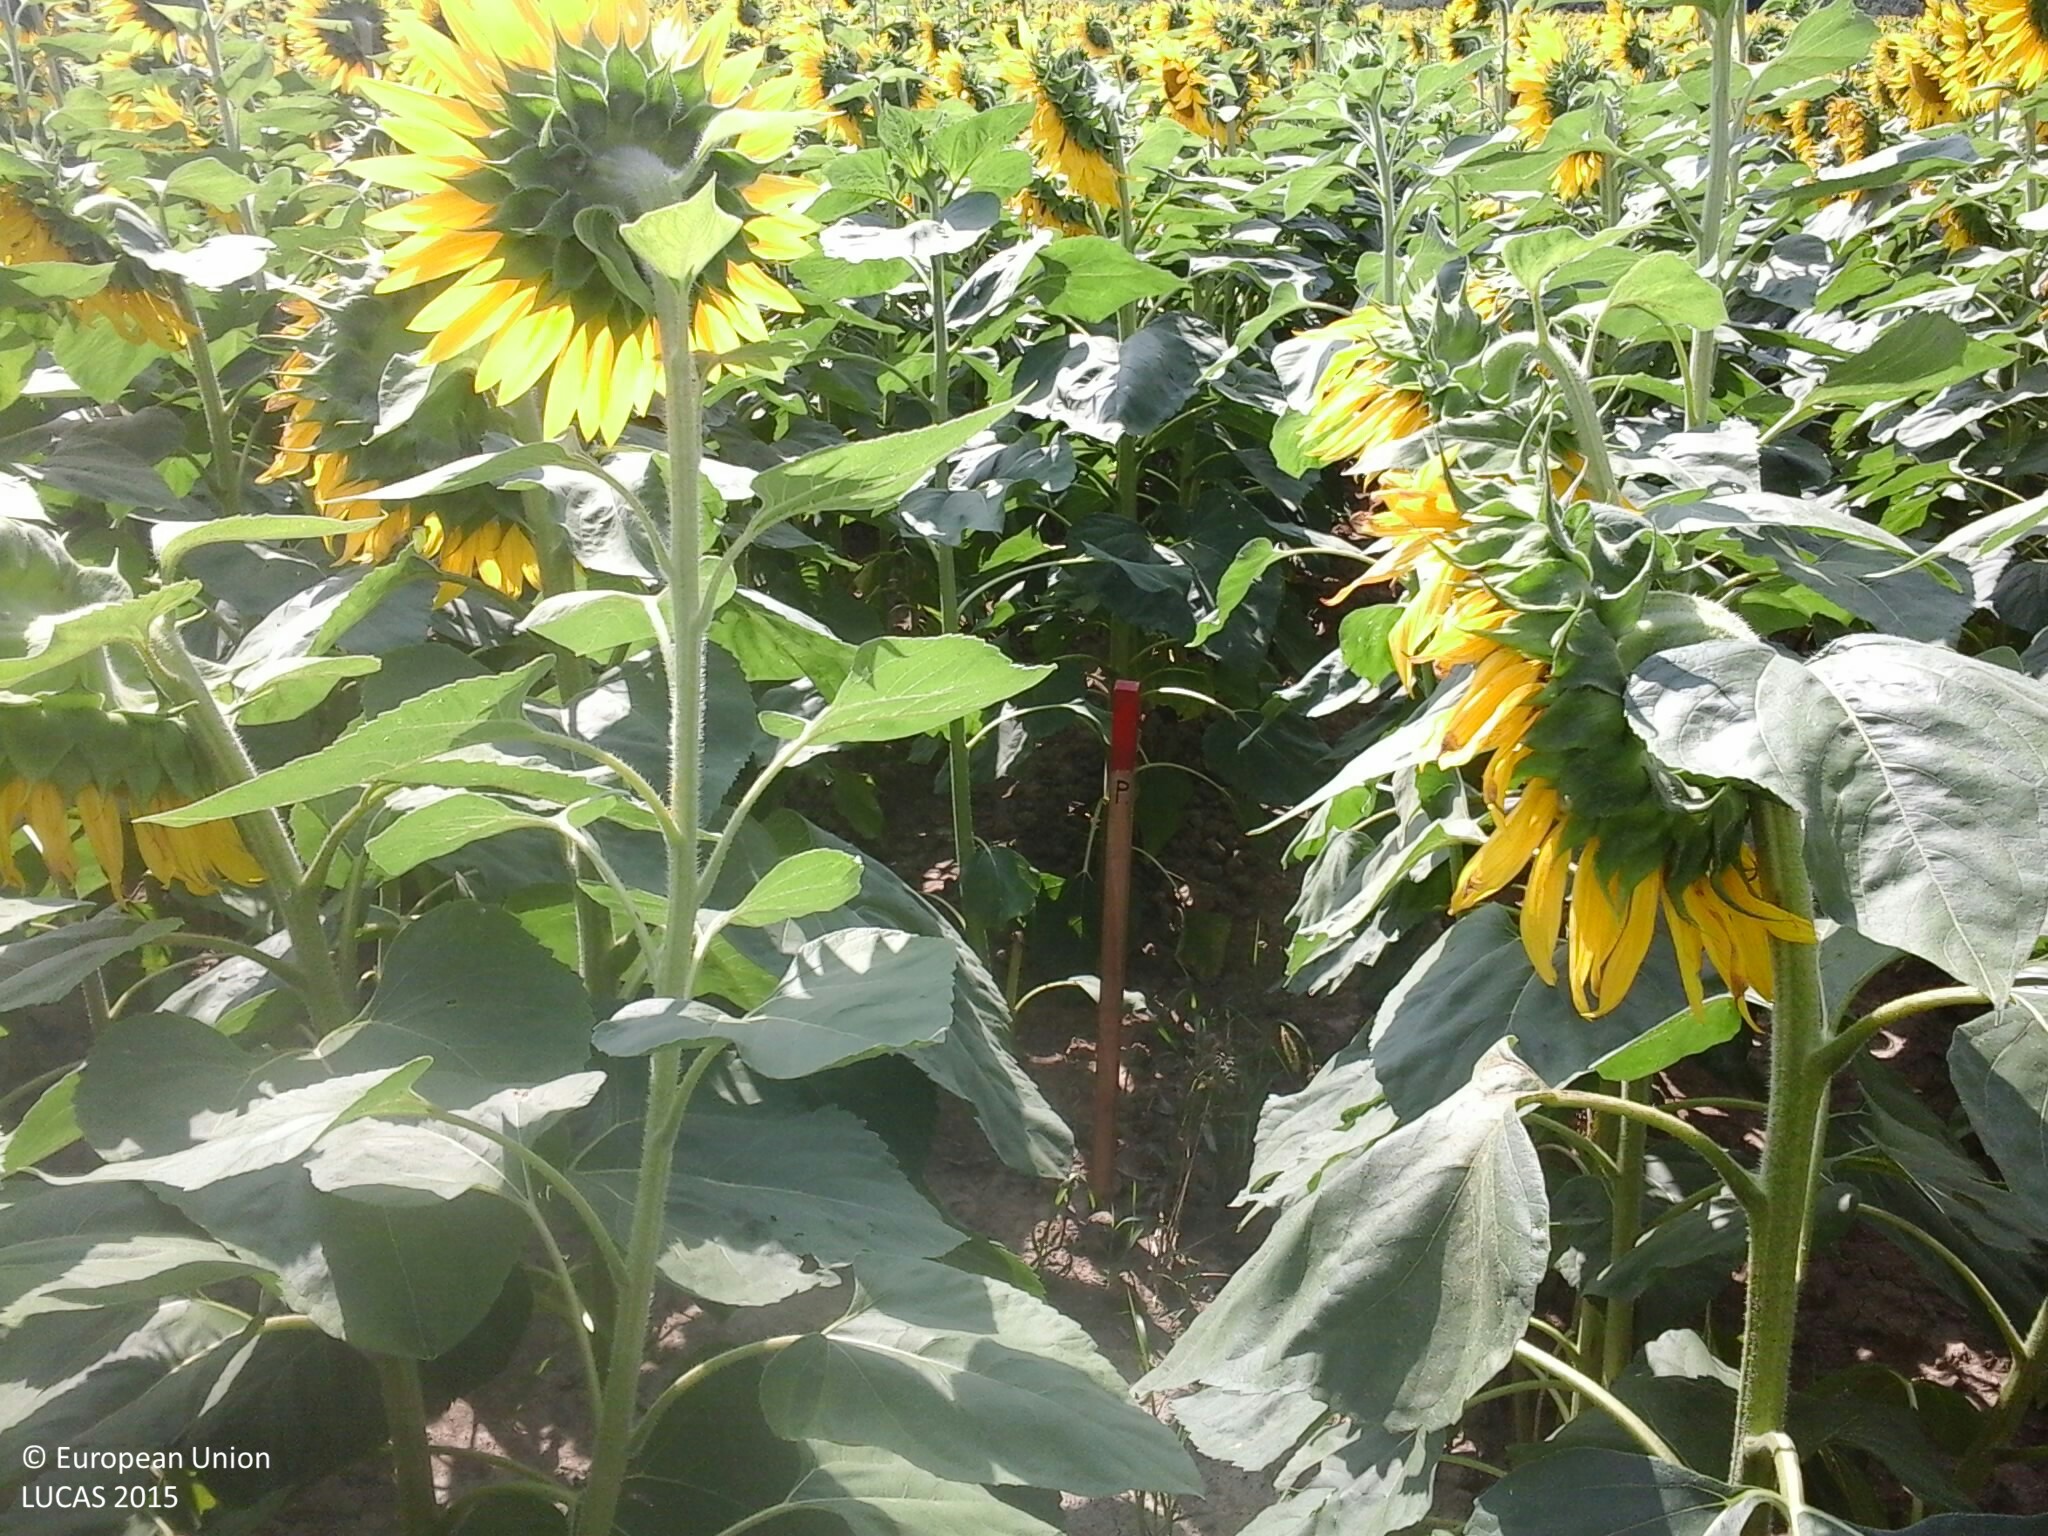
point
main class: Cropland
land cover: Sunflower
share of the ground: > 75 %
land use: Agriculture (excluding fallow land and kitchen gardens)
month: July
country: HU
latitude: 47.0344
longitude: 16.5695
